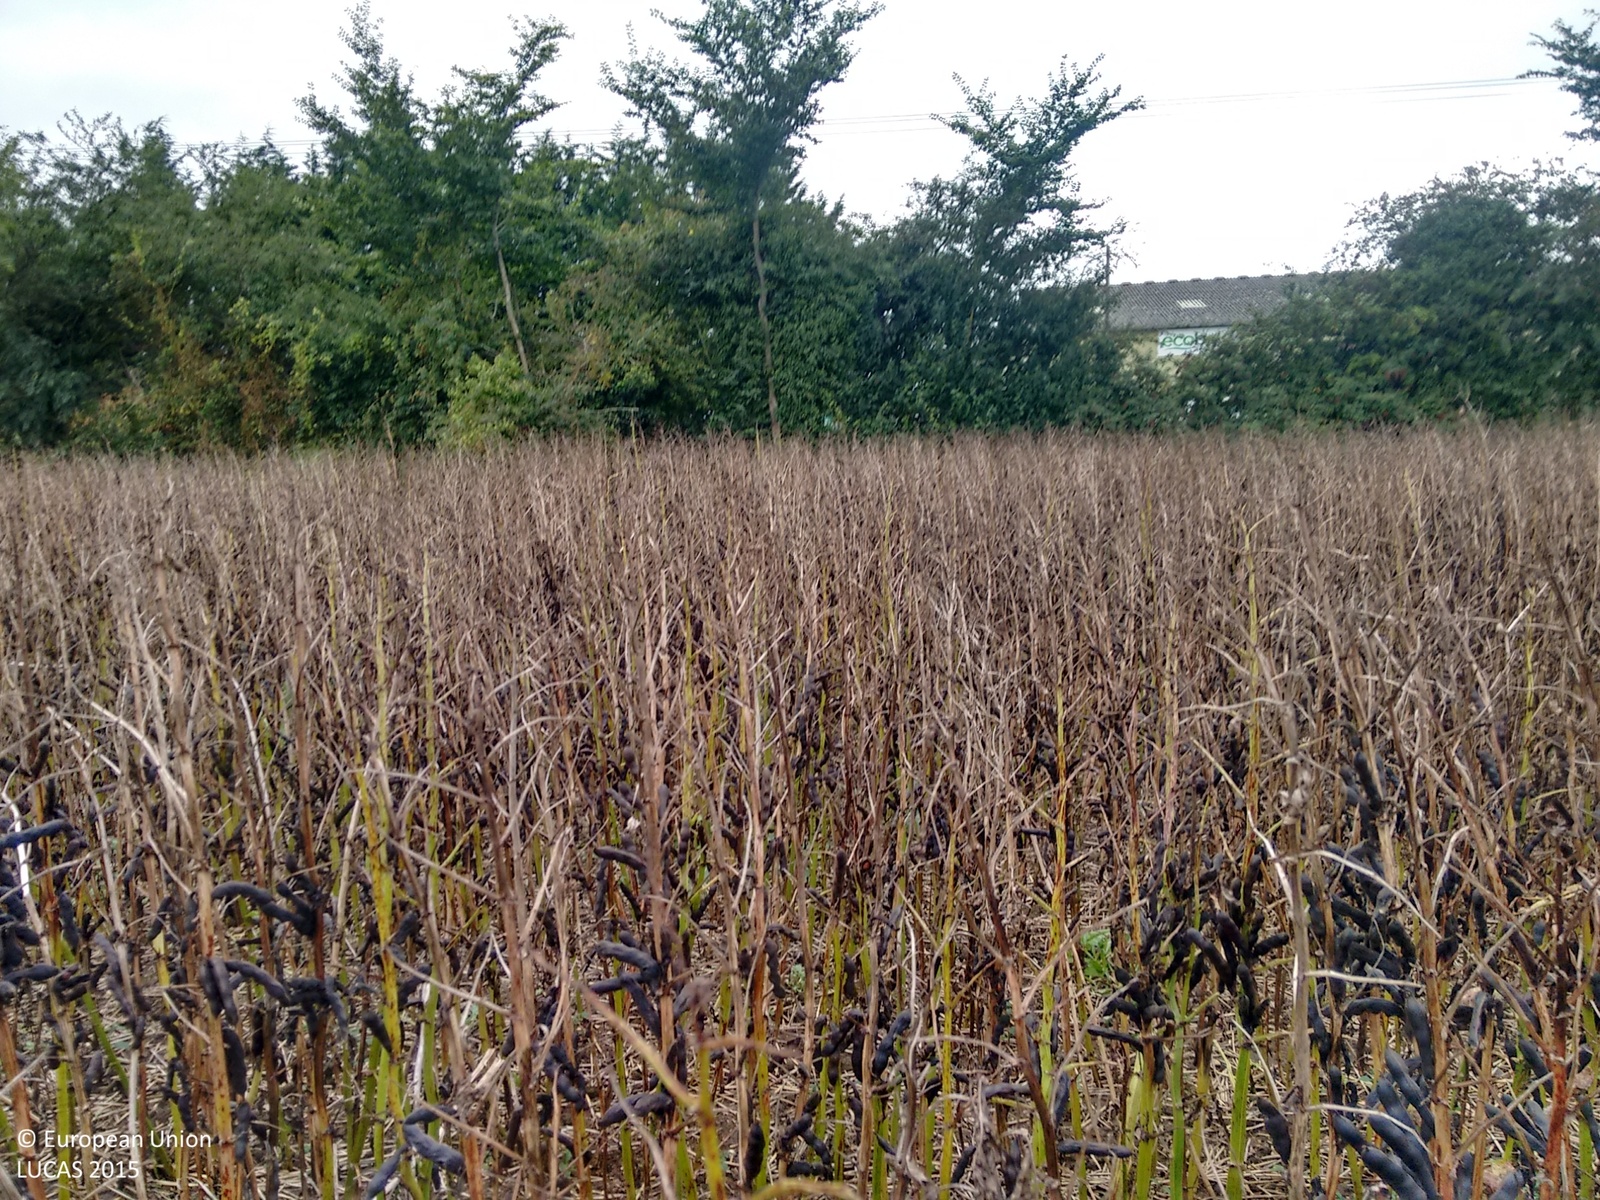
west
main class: Cropland
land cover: Dry pulses
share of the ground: > 75 %
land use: Agriculture (excluding fallow land and kitchen gardens)
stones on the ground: < 10 %
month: September
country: GB
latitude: 52.3260
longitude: 0.3307
